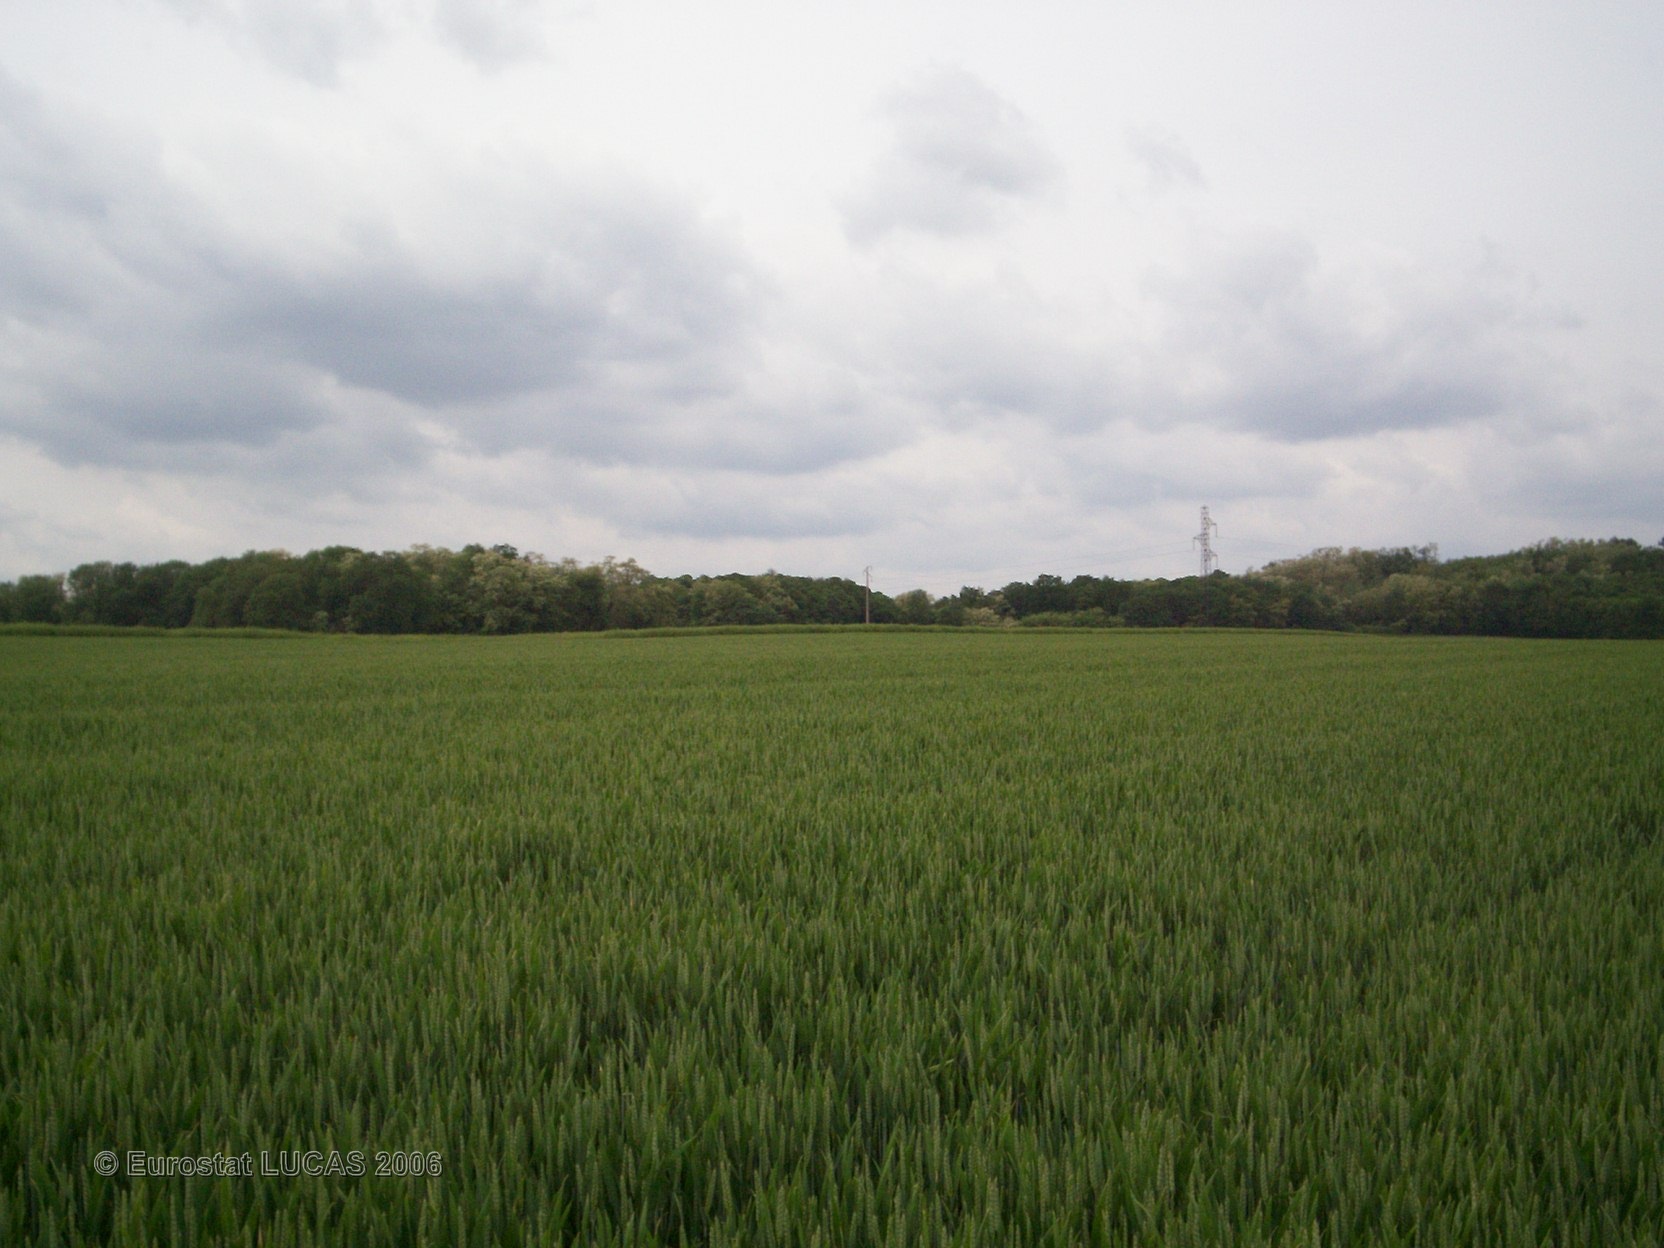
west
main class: Cropland
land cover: Common wheat
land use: Agriculture (excluding fallow land and kitchen gardens)
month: June
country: FR
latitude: 49.3743
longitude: 2.7312
